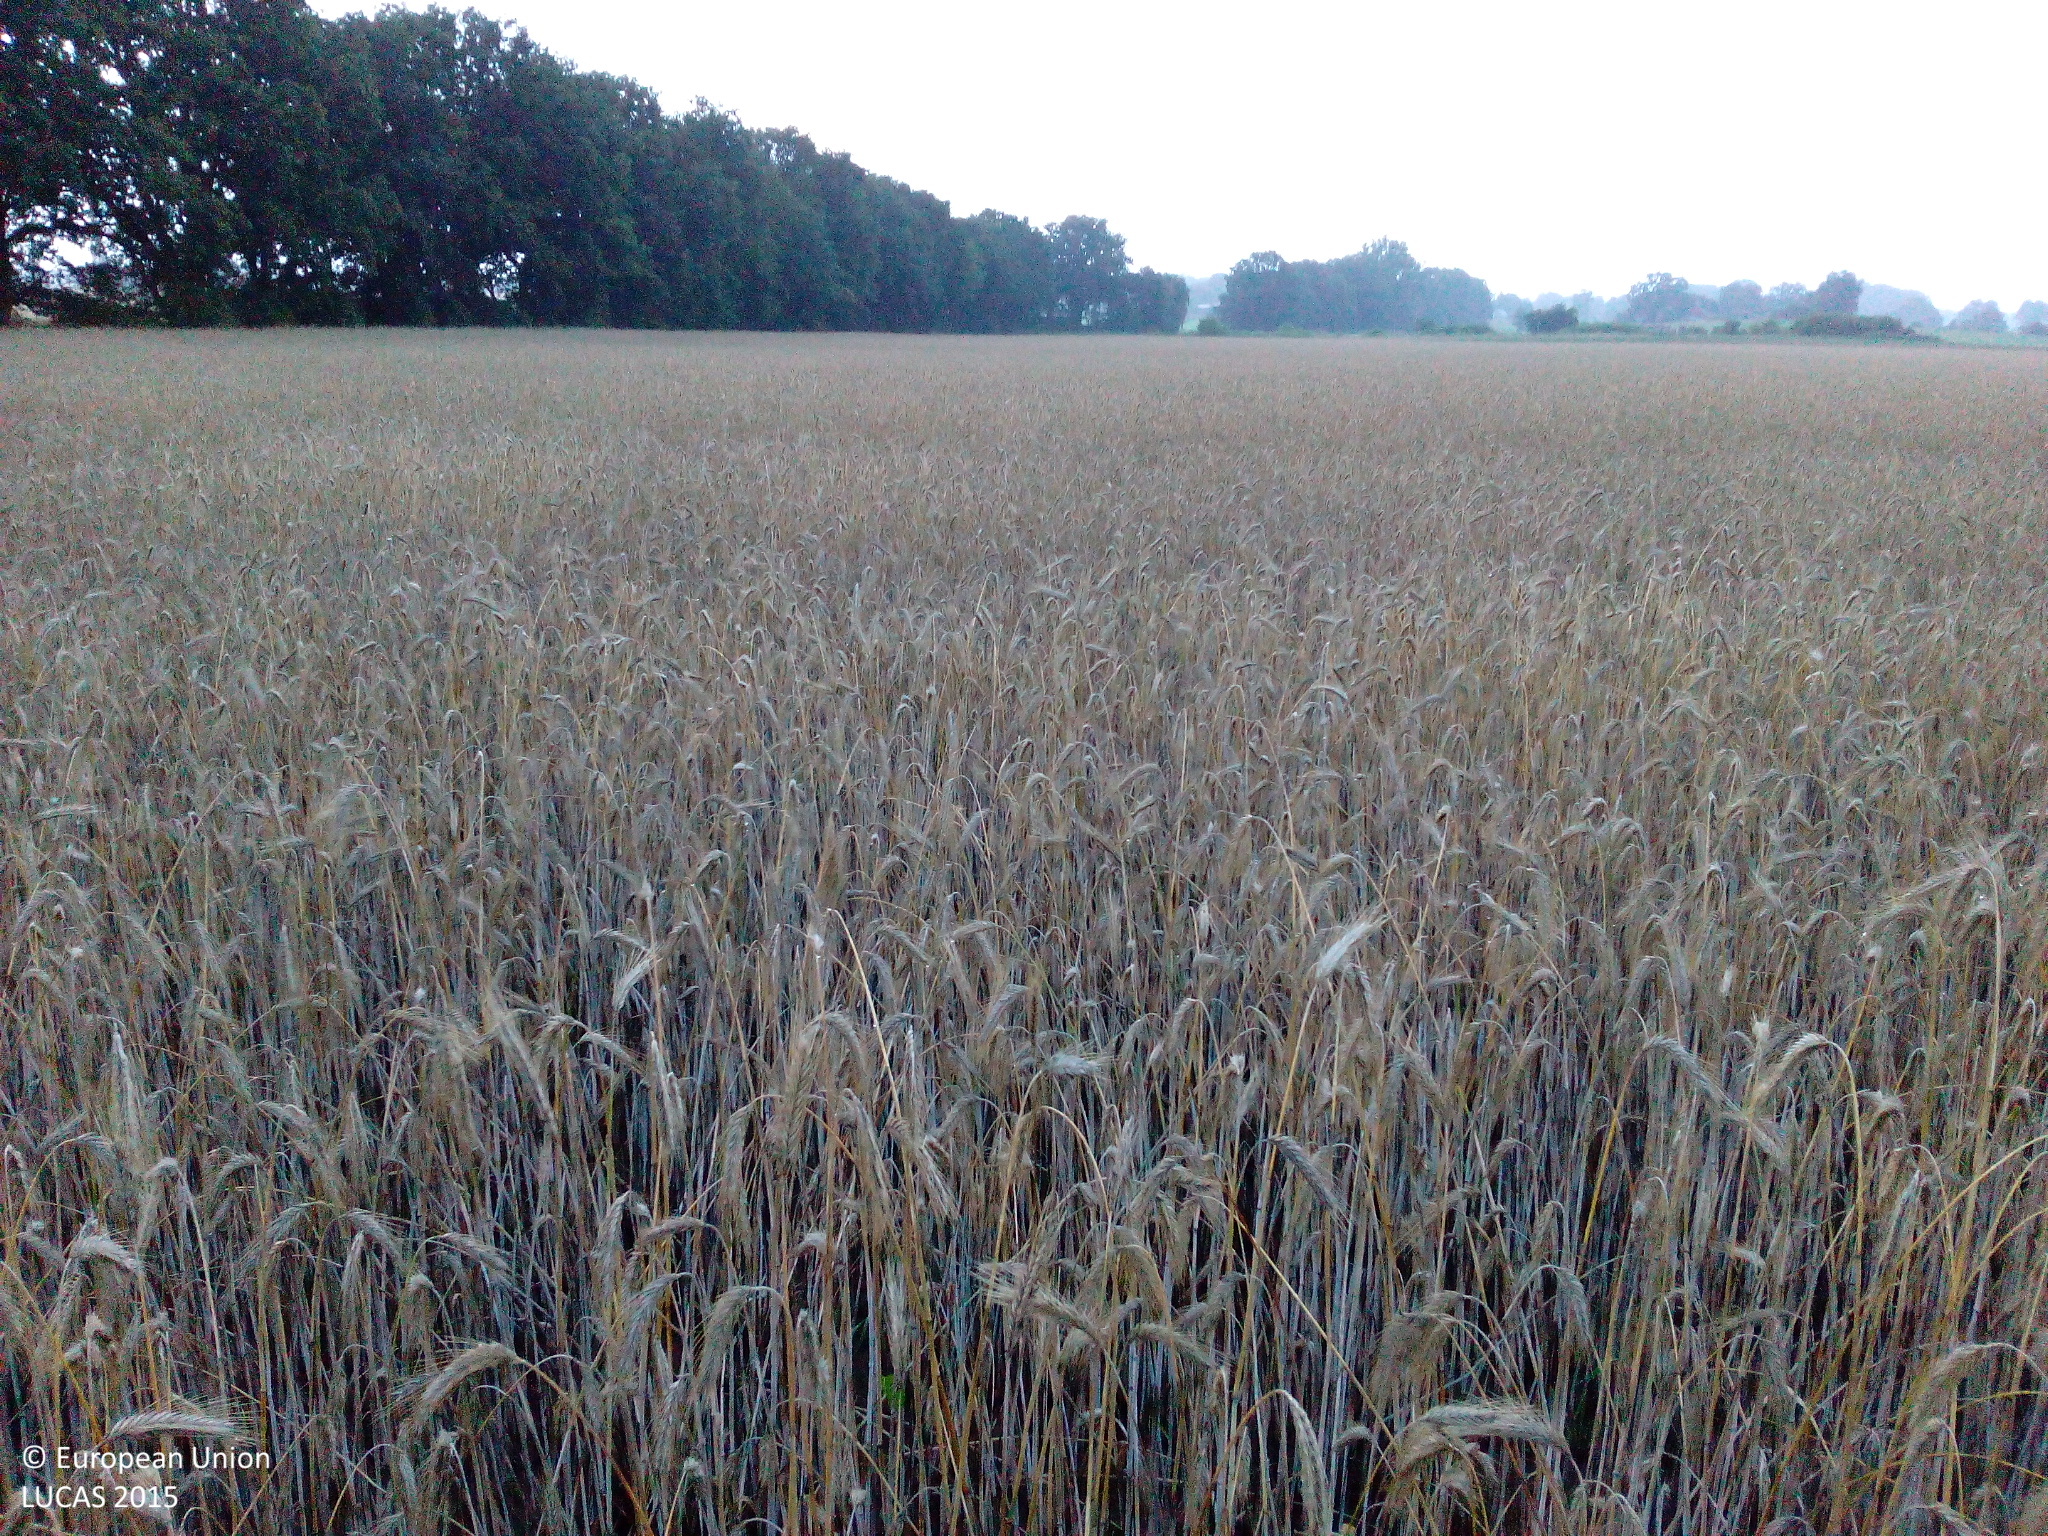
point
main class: Cropland
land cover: Rye
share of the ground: > 75 %
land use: Agriculture (excluding fallow land and kitchen gardens)
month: July
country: DE
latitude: 53.1617
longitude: 12.4373
